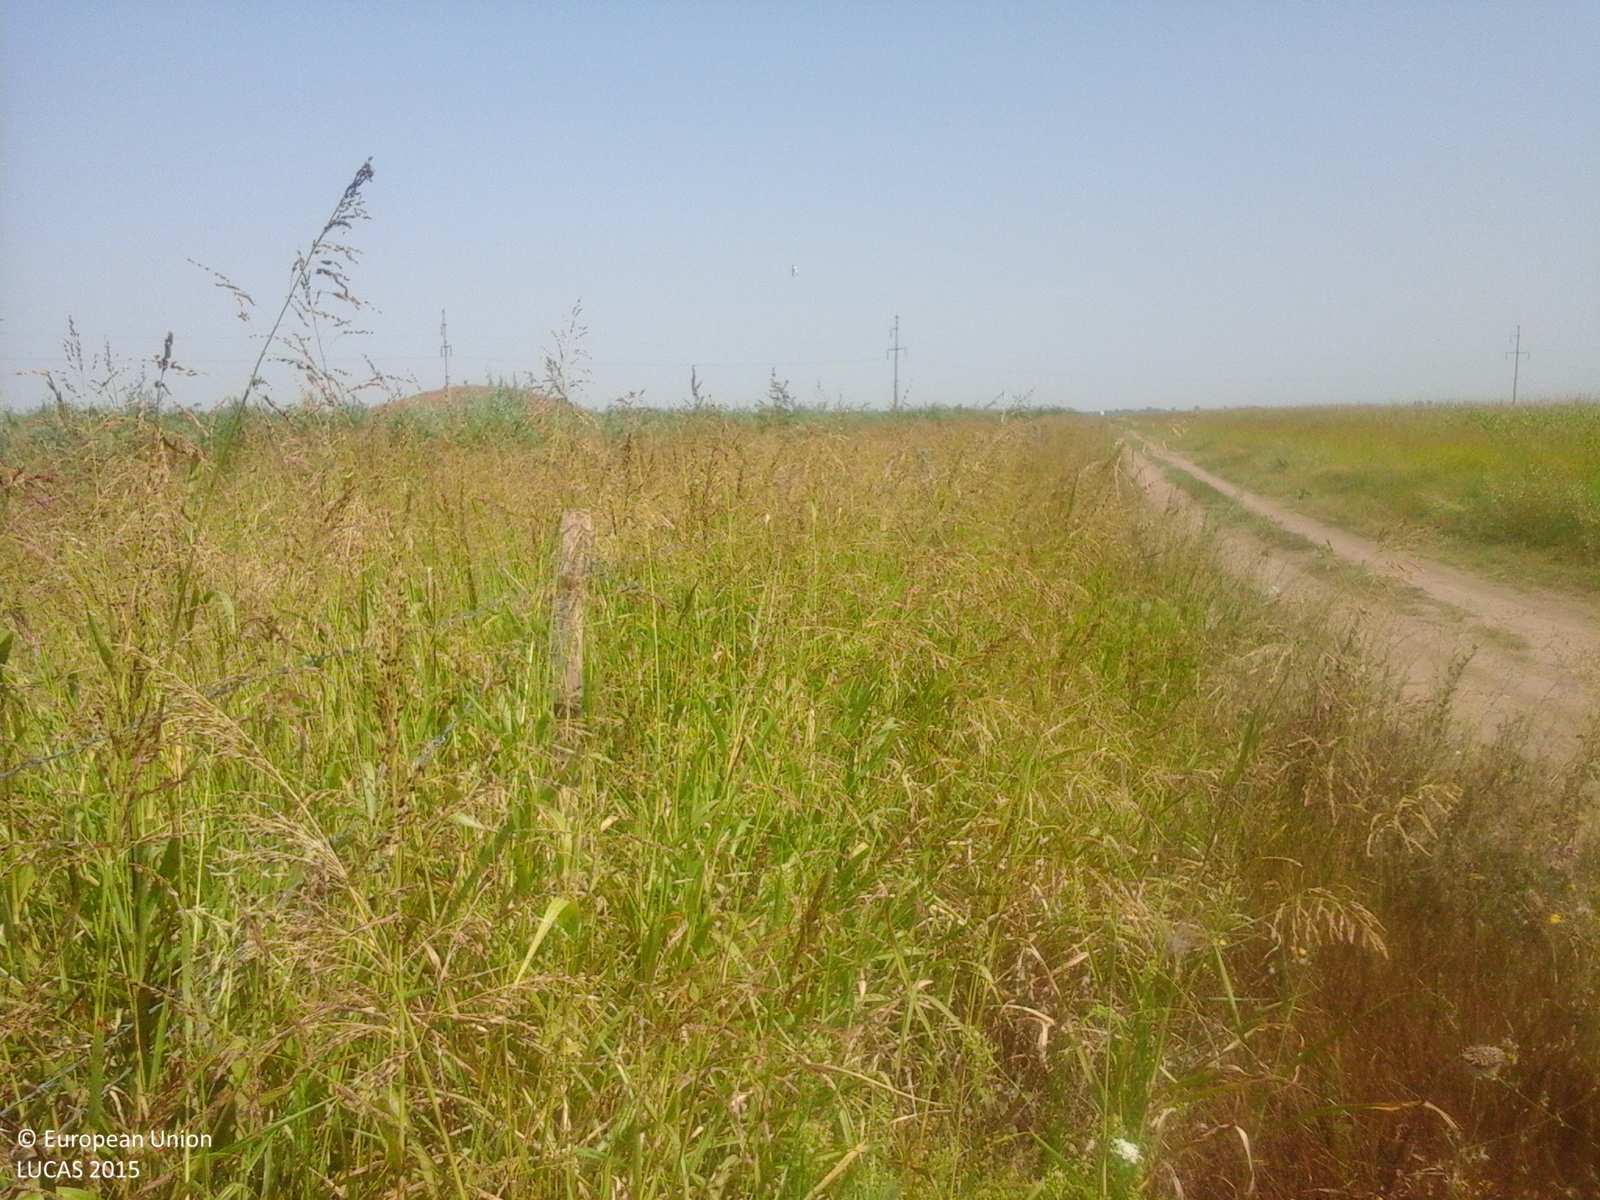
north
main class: Woodland
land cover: Broadleaved woodland
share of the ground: 10 - 25 %
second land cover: Spontaneously vegetated surfaces
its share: > 75 %
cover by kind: herbaceous plants 80 %, broadleaved forest trees 20 %
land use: Forestry
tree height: < 5 m
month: August
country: RO
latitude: 45.1334
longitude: 27.7162
